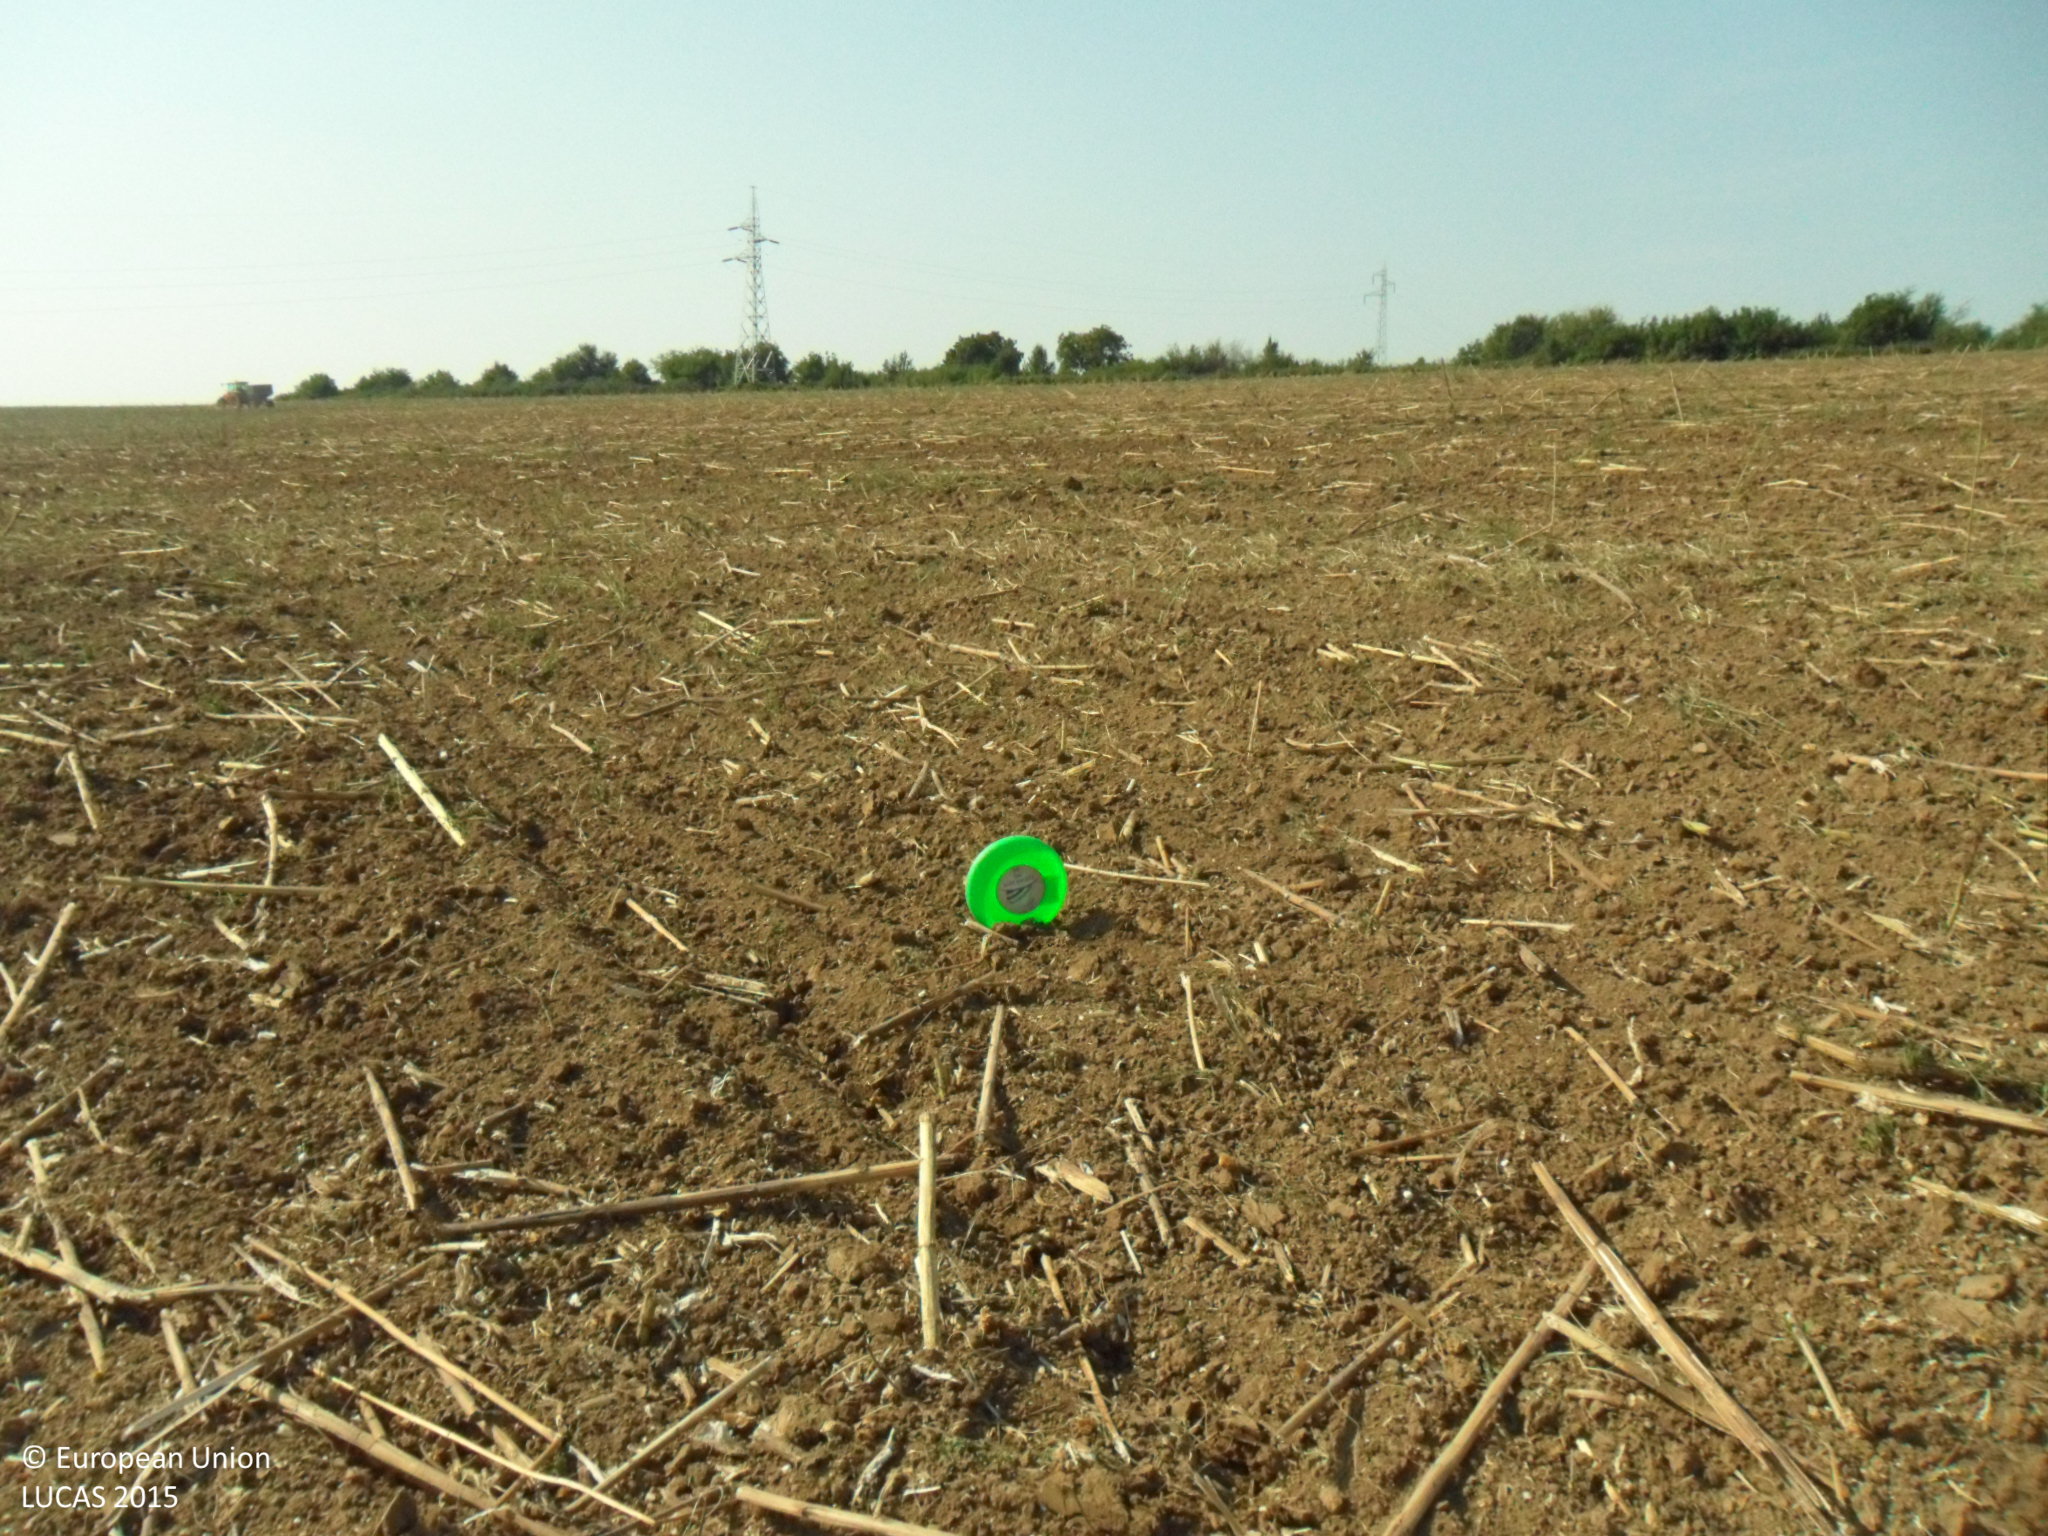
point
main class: Cropland
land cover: Sunflower
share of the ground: < 10 %
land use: Agriculture (excluding fallow land and kitchen gardens)
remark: Harvested field
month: September
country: BG
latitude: 43.6367
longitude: 26.2006
